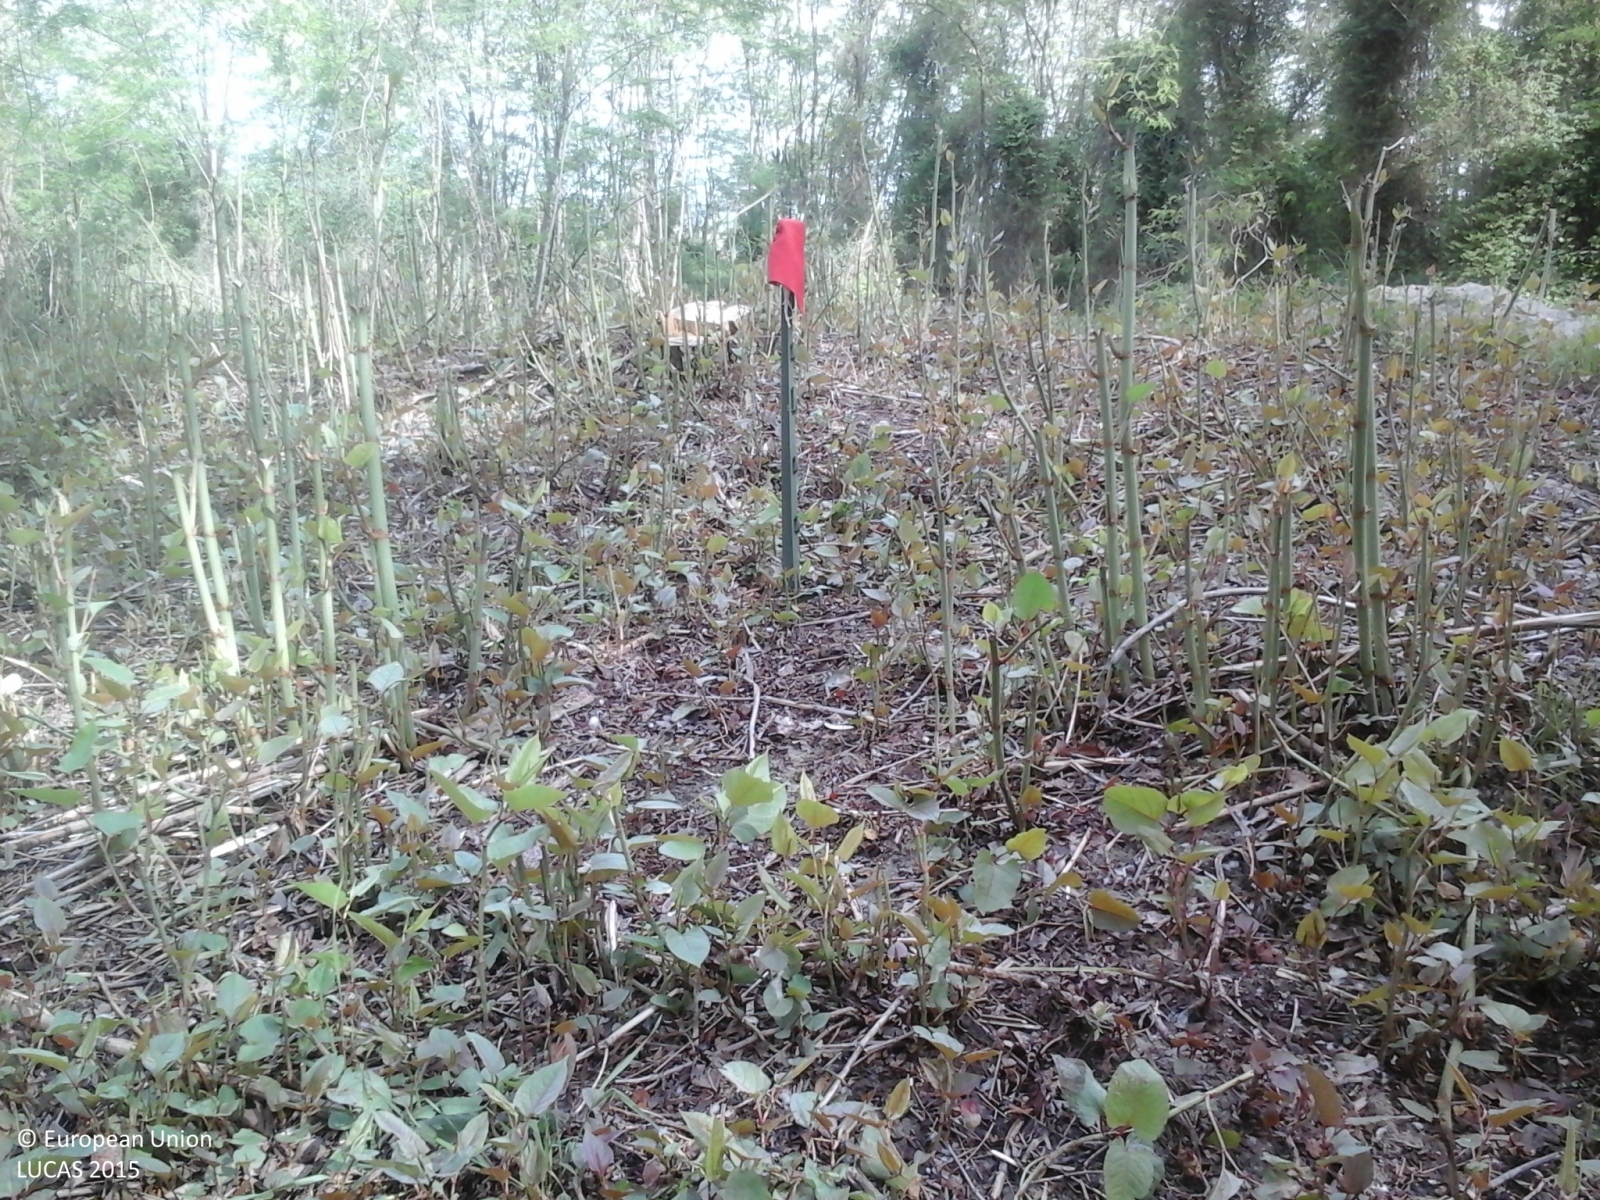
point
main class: Woodland
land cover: Broadleaved woodland
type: non-riverine alder, birch or aspen forest
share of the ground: > 75 %
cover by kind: broadleaved forest trees 100 %
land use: Forestry
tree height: < 5 m
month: May
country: IT
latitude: 45.7069
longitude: 8.2943
